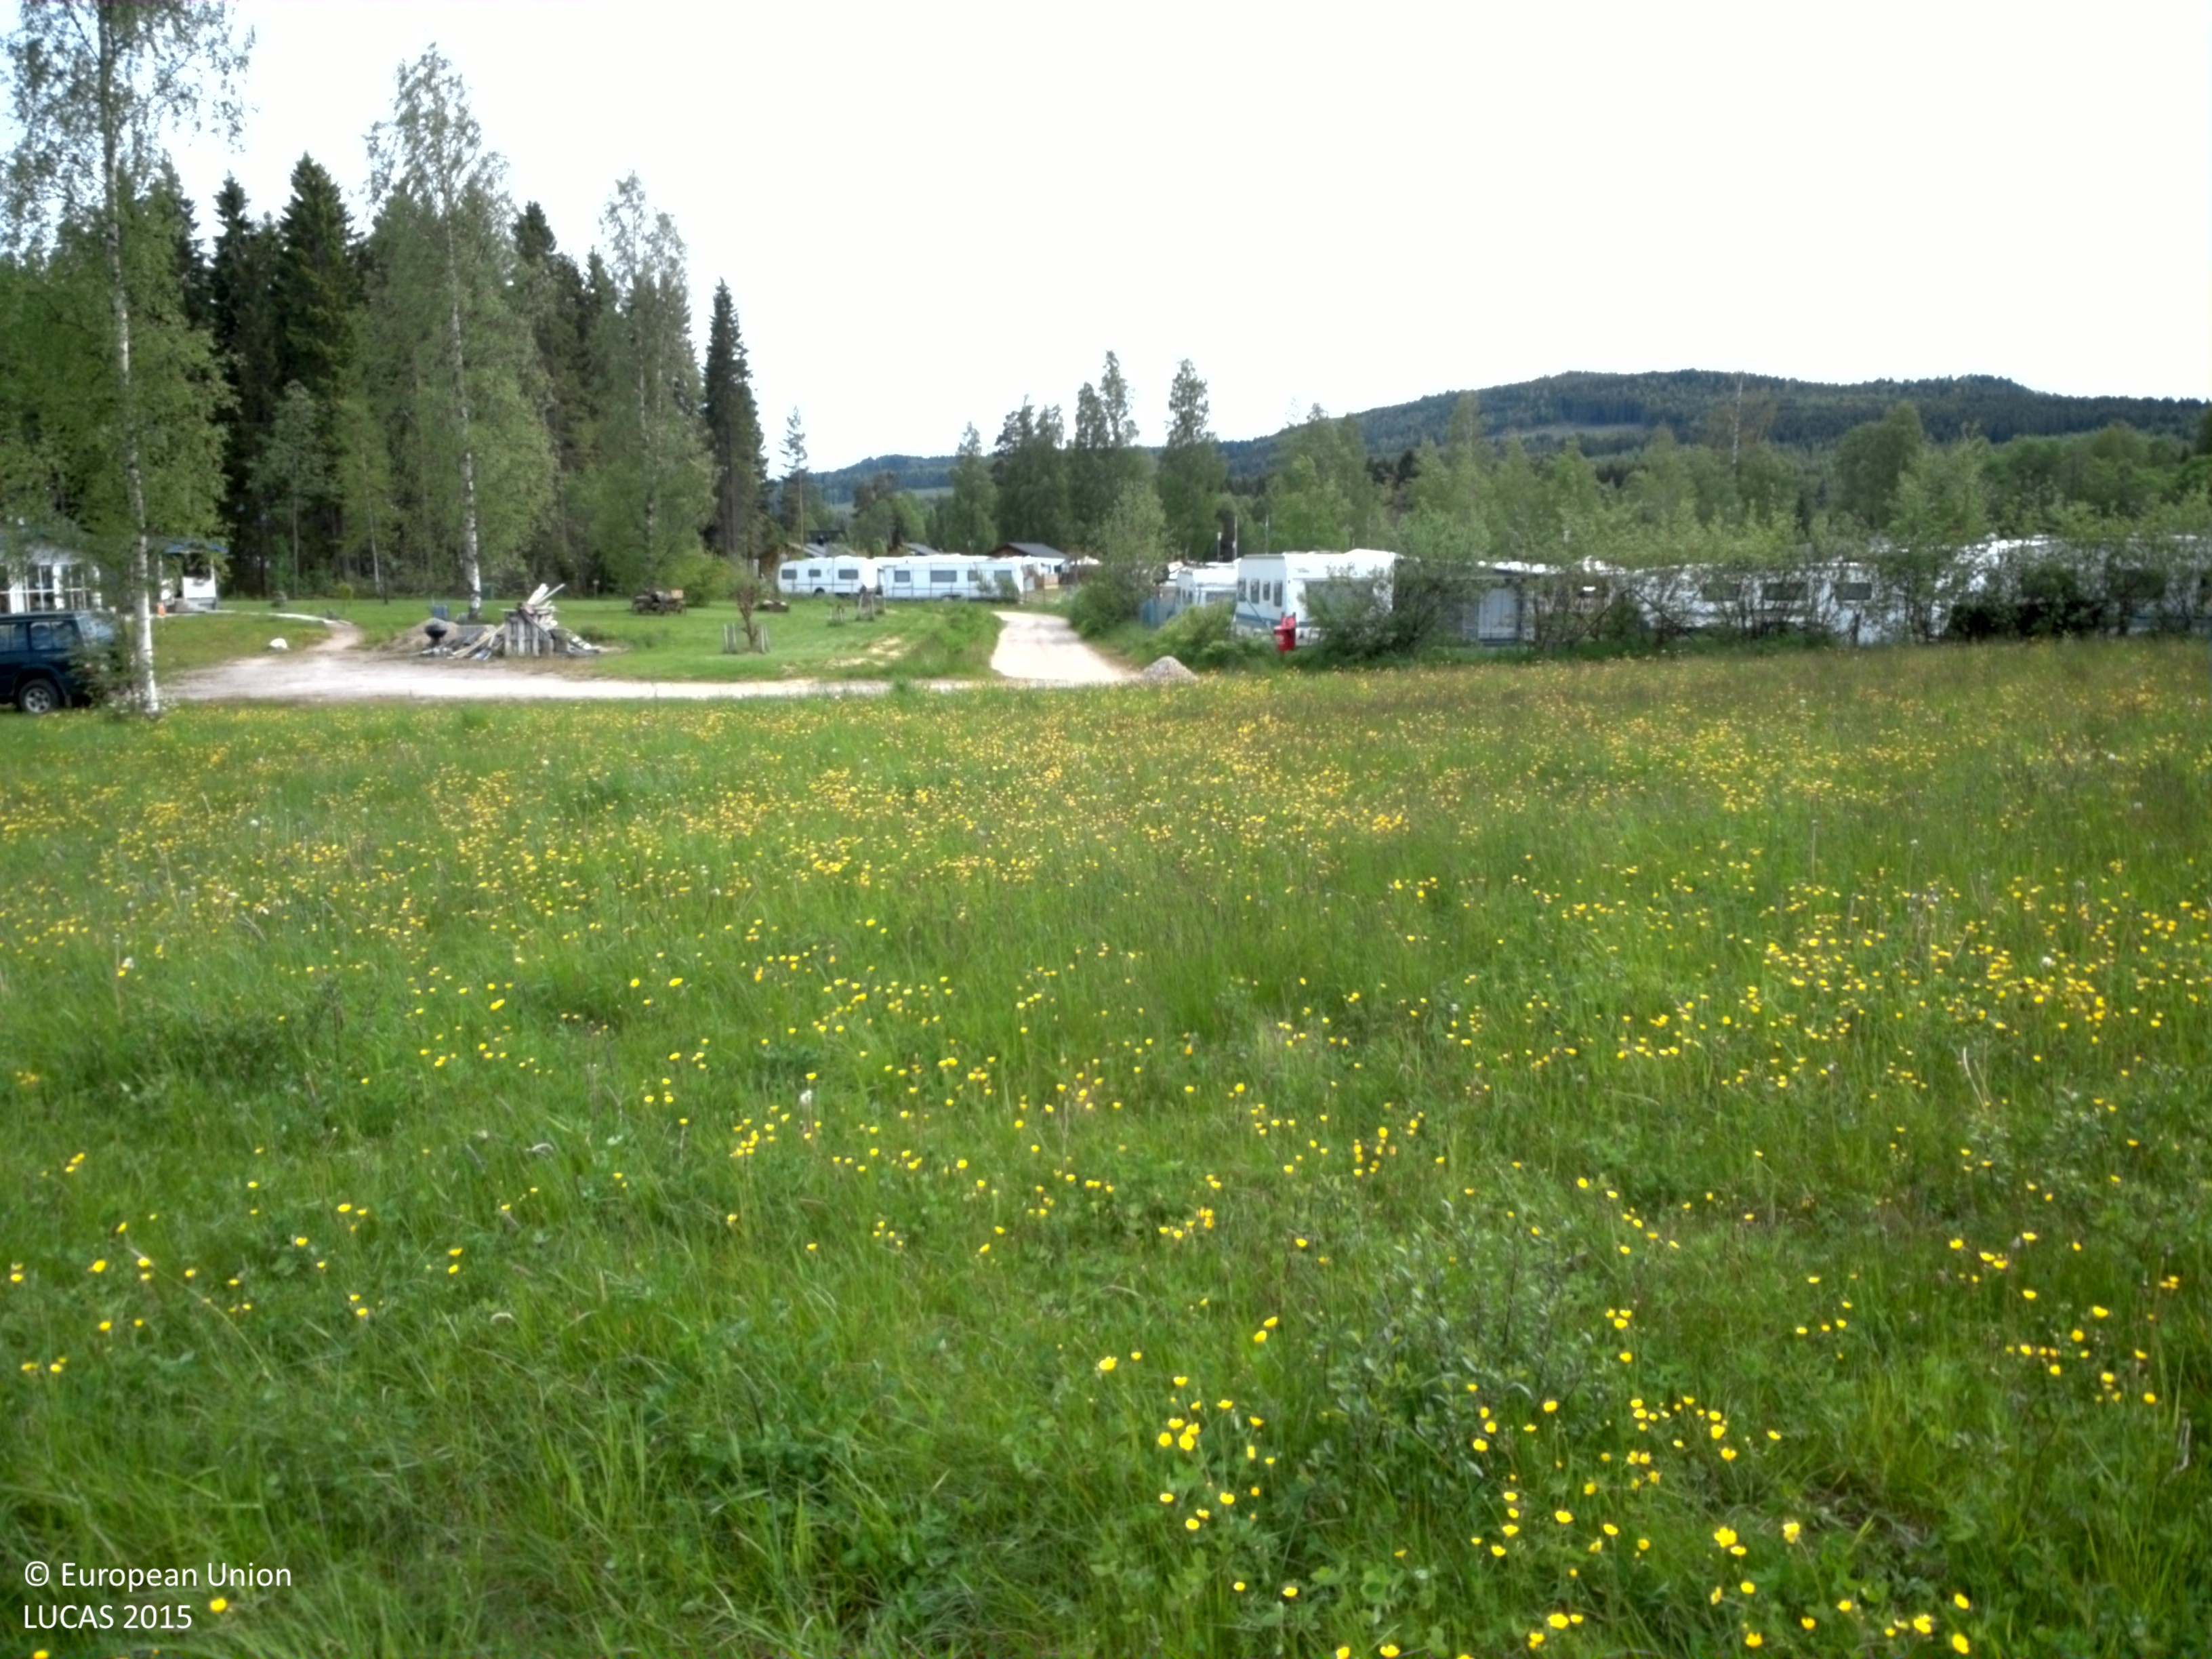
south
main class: Grassland
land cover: Grassland without tree/shrub cover
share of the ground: > 75 %
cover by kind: herbaceous plants 100 %
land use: Agriculture (excluding fallow land and kitchen gardens)
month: June
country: SE
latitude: 60.0941
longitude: 13.0303
